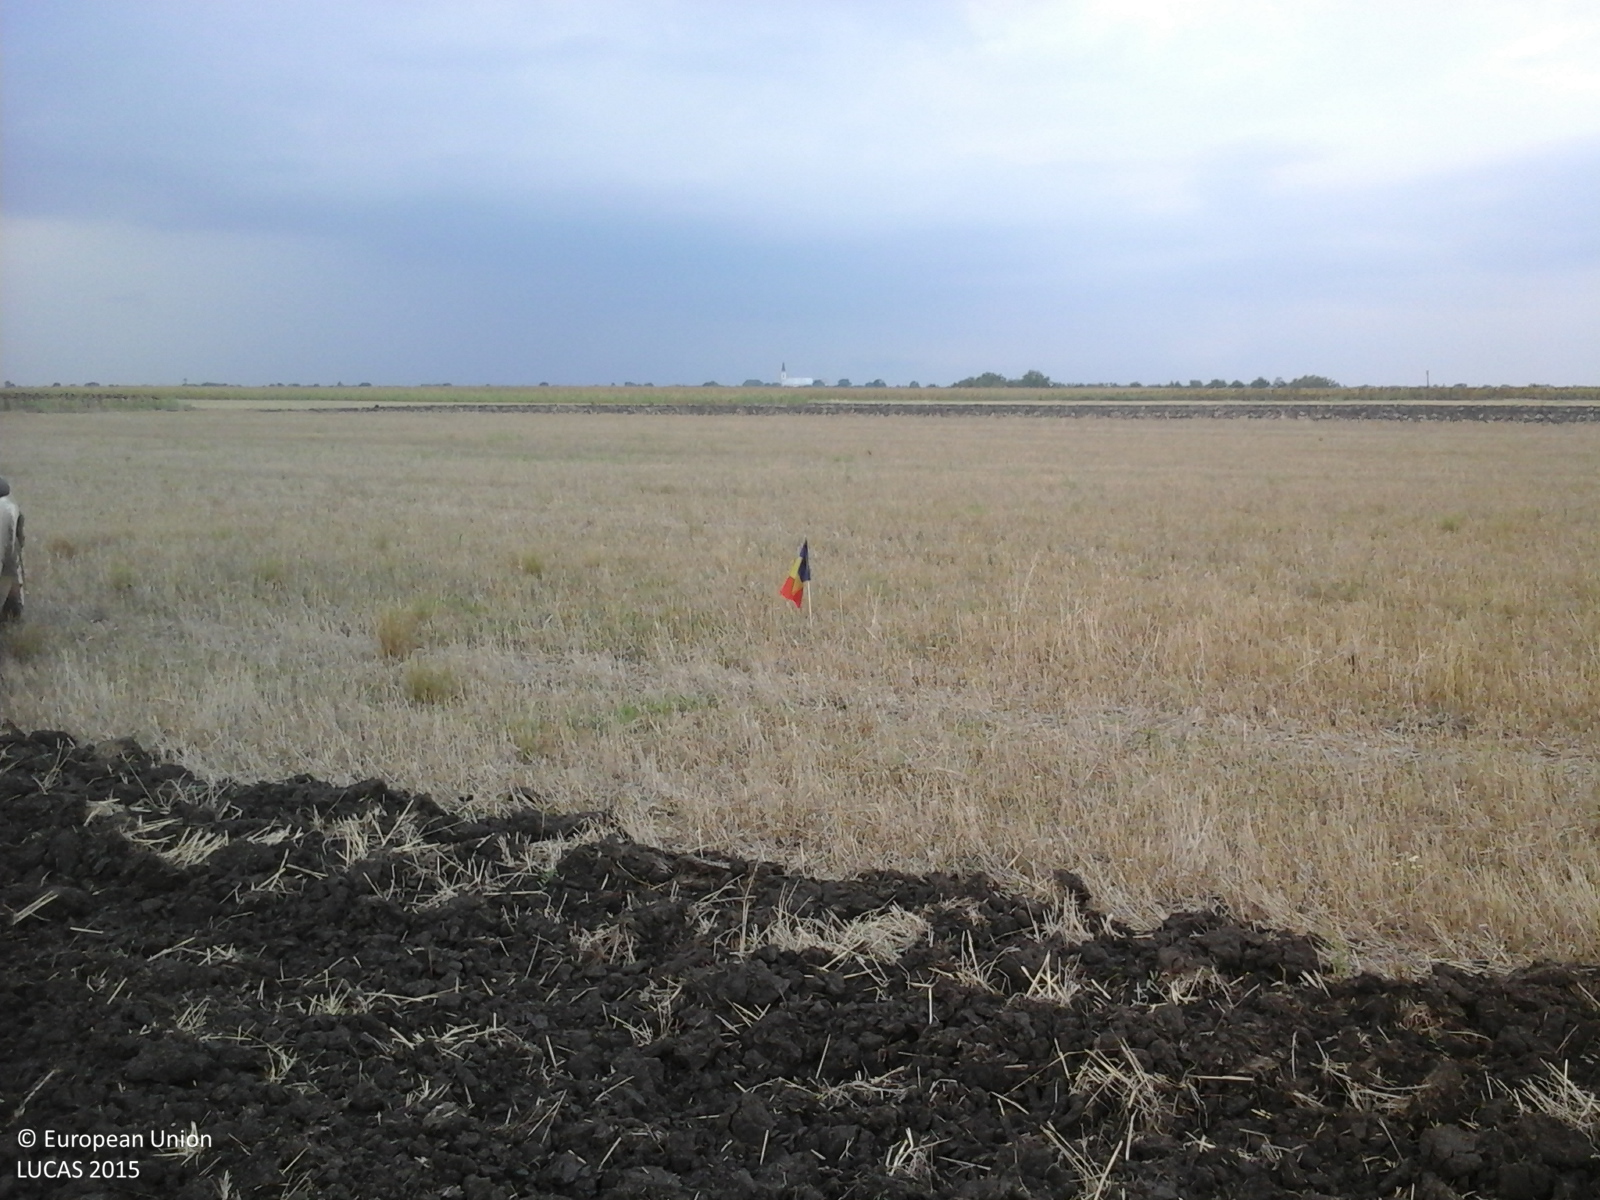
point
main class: Cropland
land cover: Durum wheat
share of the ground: 25 - 50 %
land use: Agriculture (excluding fallow land and kitchen gardens)
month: August
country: RO
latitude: 46.0325
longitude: 20.5024
